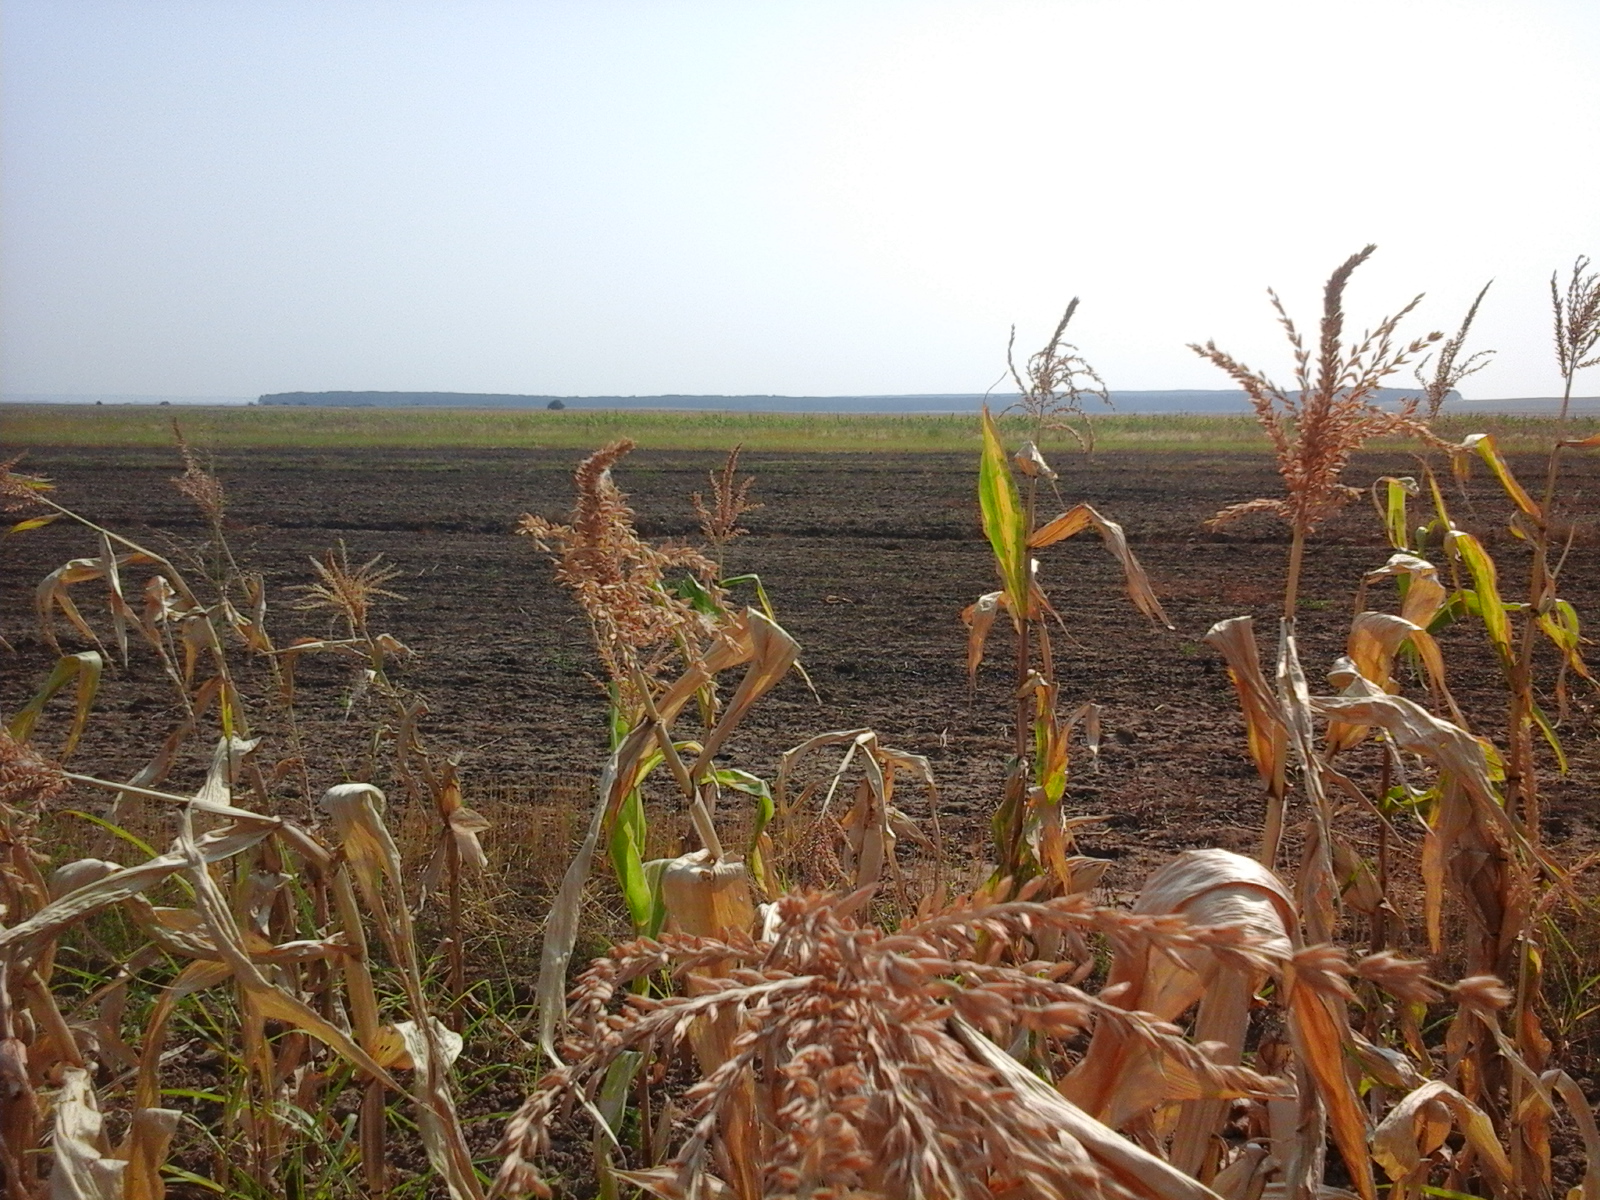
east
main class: Cropland
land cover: Maize
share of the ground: > 75 %
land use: Agriculture (excluding fallow land and kitchen gardens)
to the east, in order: Maize; Common wheat; Oats; Grassland without tree/shrub cover; Maize; Common wheat; Grassland without tree/shrub cover; Lucerne; Common wheat; Maize; Spontaneously vegetated surfaces
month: August
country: RO
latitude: 44.3158
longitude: 22.6899
